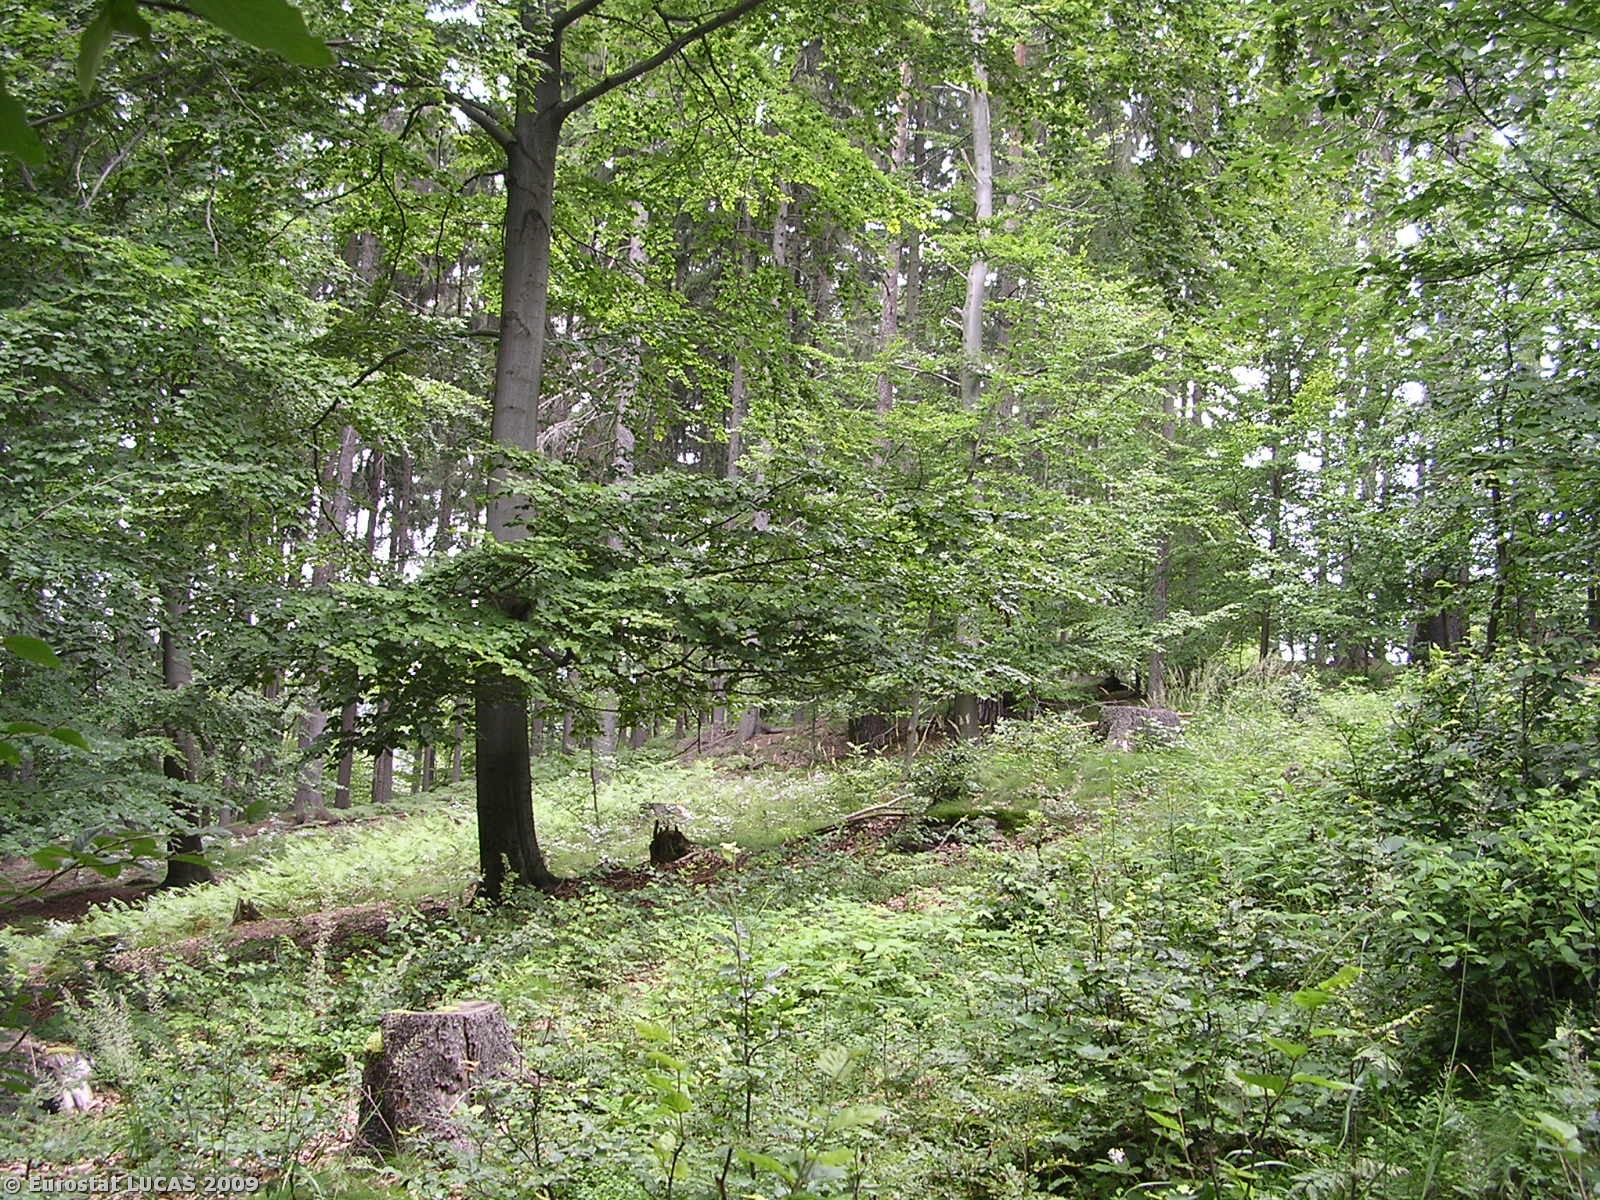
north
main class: Woodland
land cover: Mixed woodland
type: hemiboreal forest and nemoral coniferous forest and mixed broadleaved-coniferous forest
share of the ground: > 75 %
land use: Forestry
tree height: > 5 m
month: July
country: CZ
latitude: 50.8102
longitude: 15.0695
